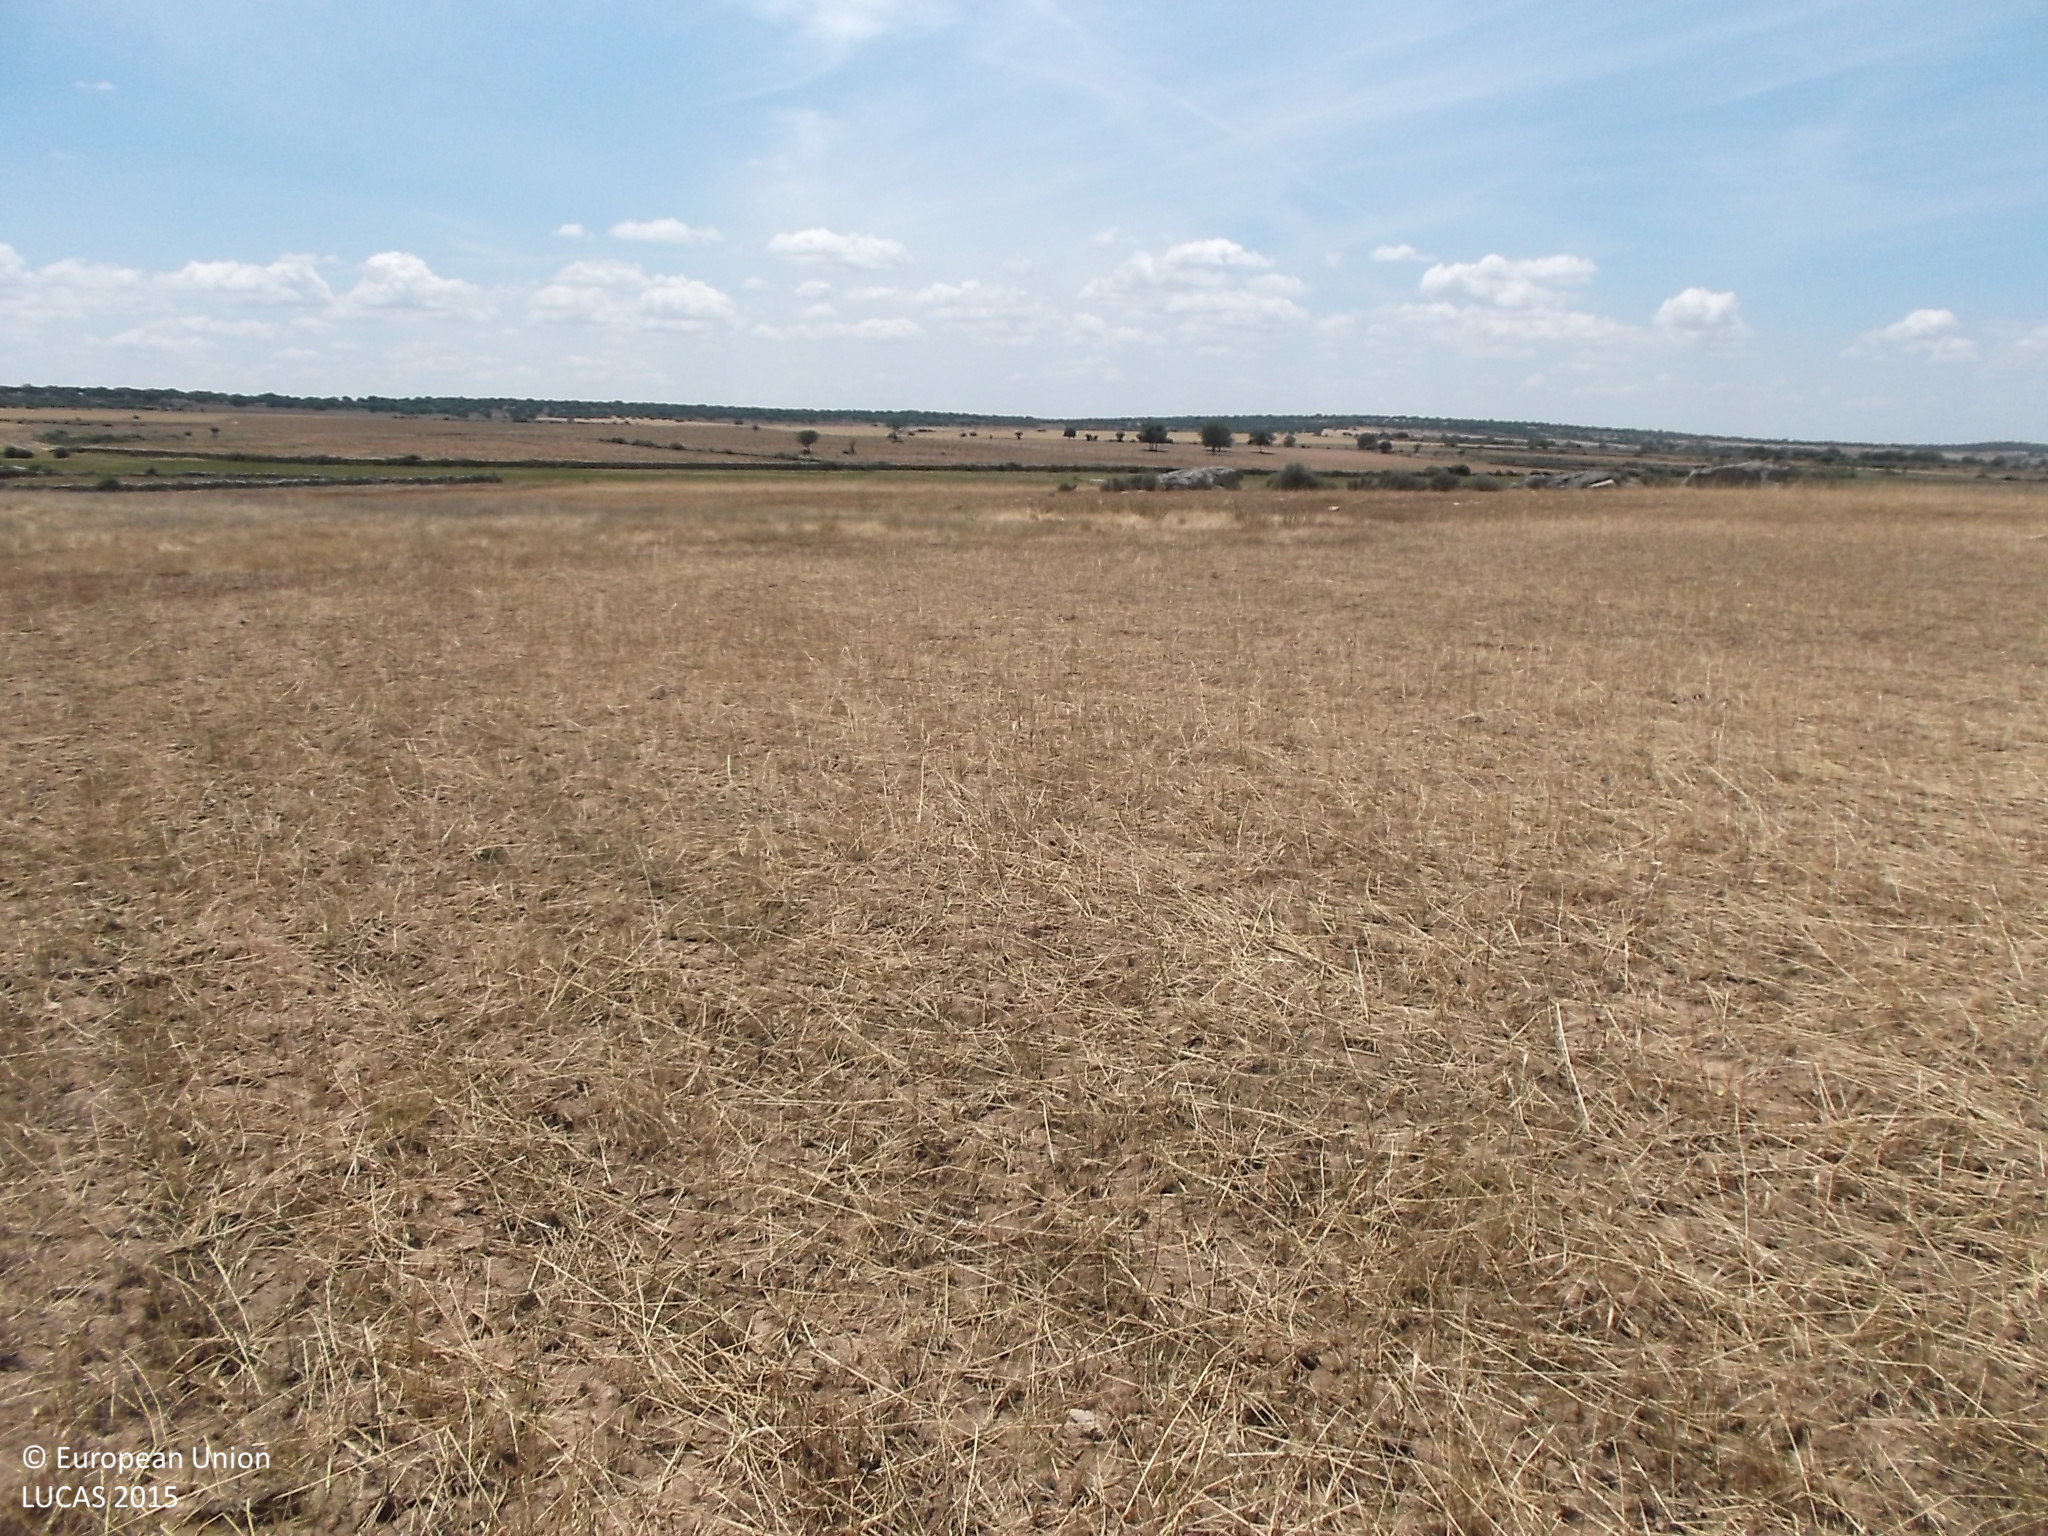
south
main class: Cropland
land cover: Rye
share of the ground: < 10 %
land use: Agriculture (excluding fallow land and kitchen gardens)
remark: Harvested field
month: June
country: ES
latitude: 41.2547
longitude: -6.0457
